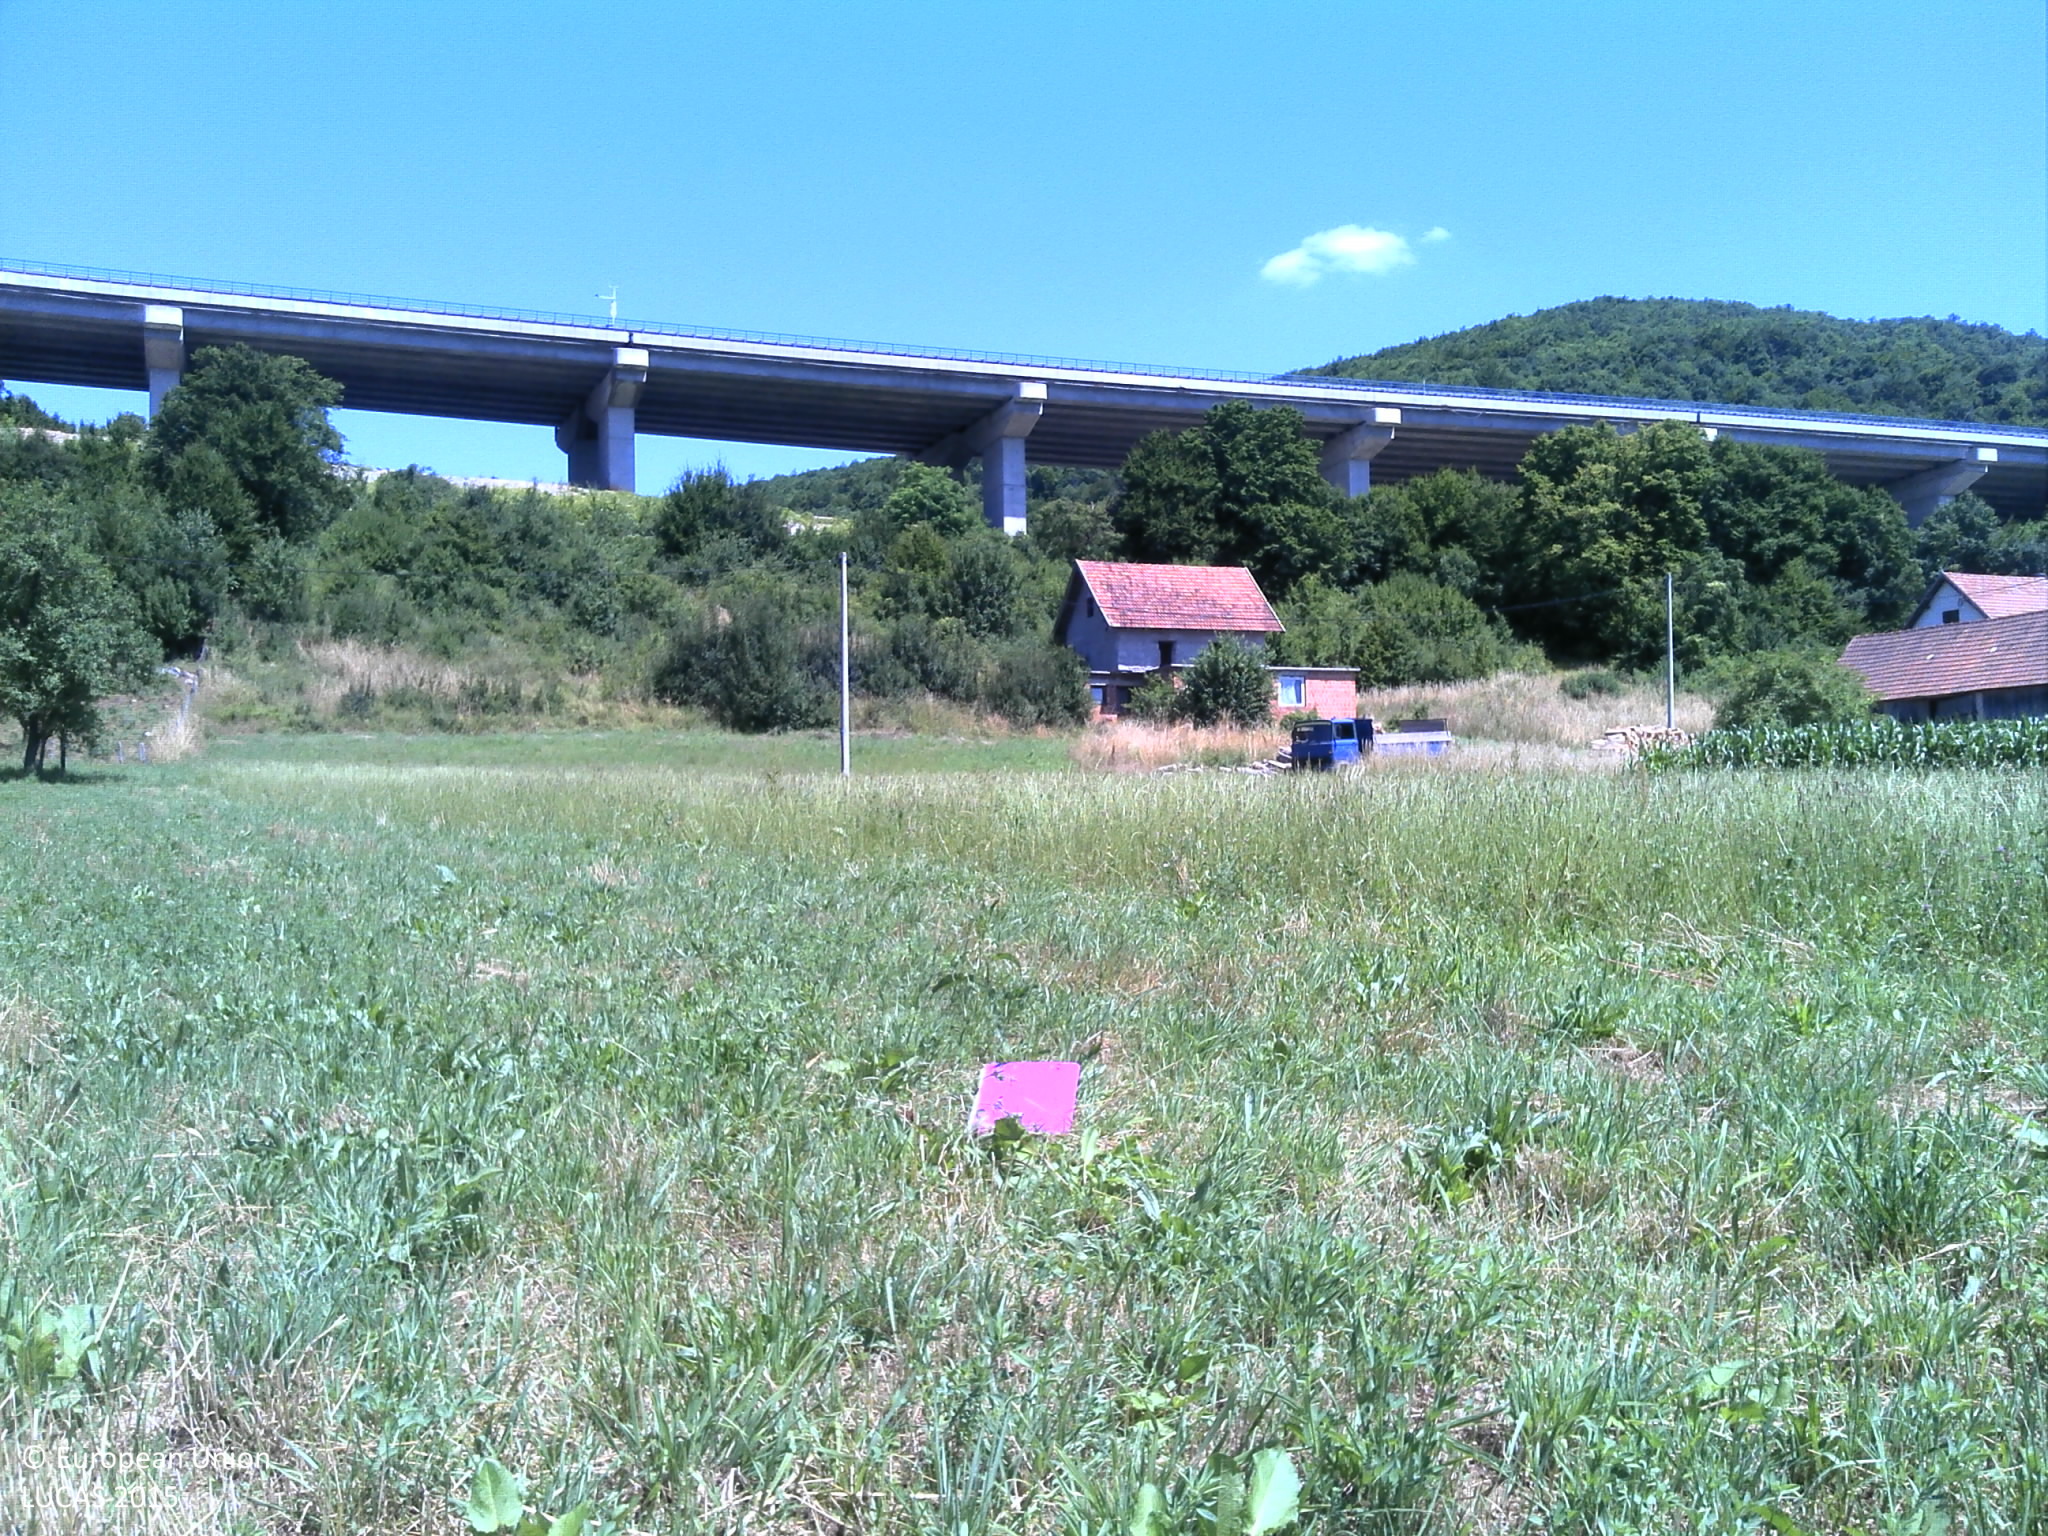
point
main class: Cropland
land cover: Temporary grasslands
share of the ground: > 75 %
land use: Agriculture (excluding fallow land and kitchen gardens)
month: July
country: HR
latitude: 44.9080
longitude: 15.1745
